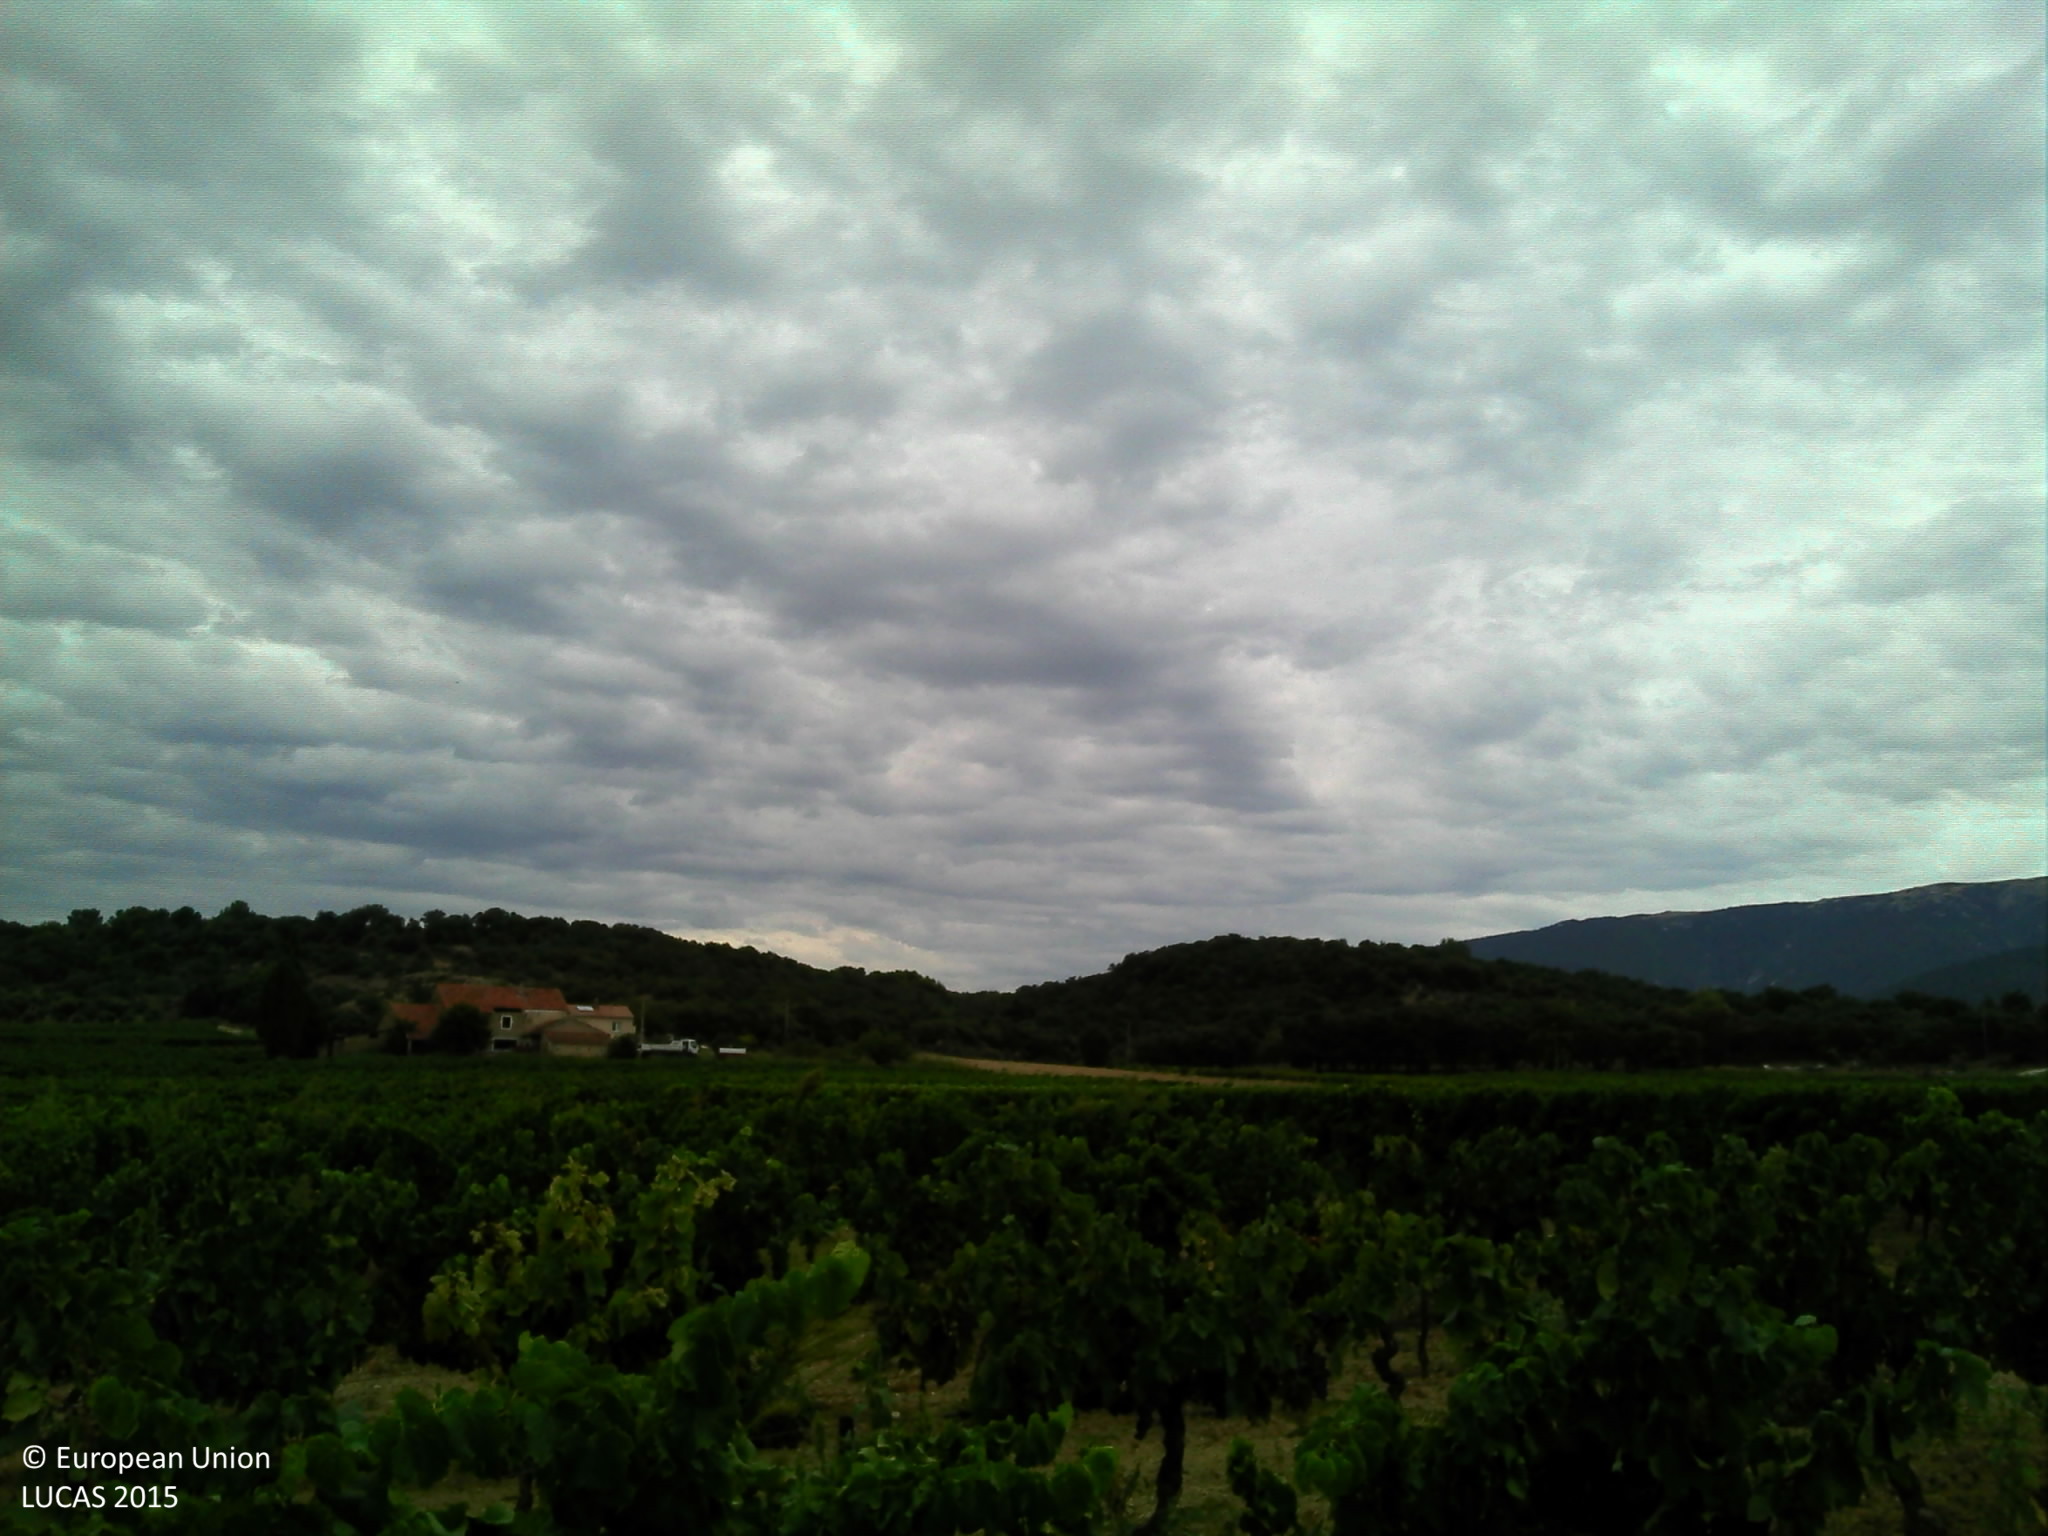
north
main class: Cropland
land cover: Vineyards
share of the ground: 50 - 75 %
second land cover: Other bare soil
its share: > 75 %
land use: Agriculture (excluding fallow land and kitchen gardens)
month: September
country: FR
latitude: 44.4118
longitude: 5.0217
